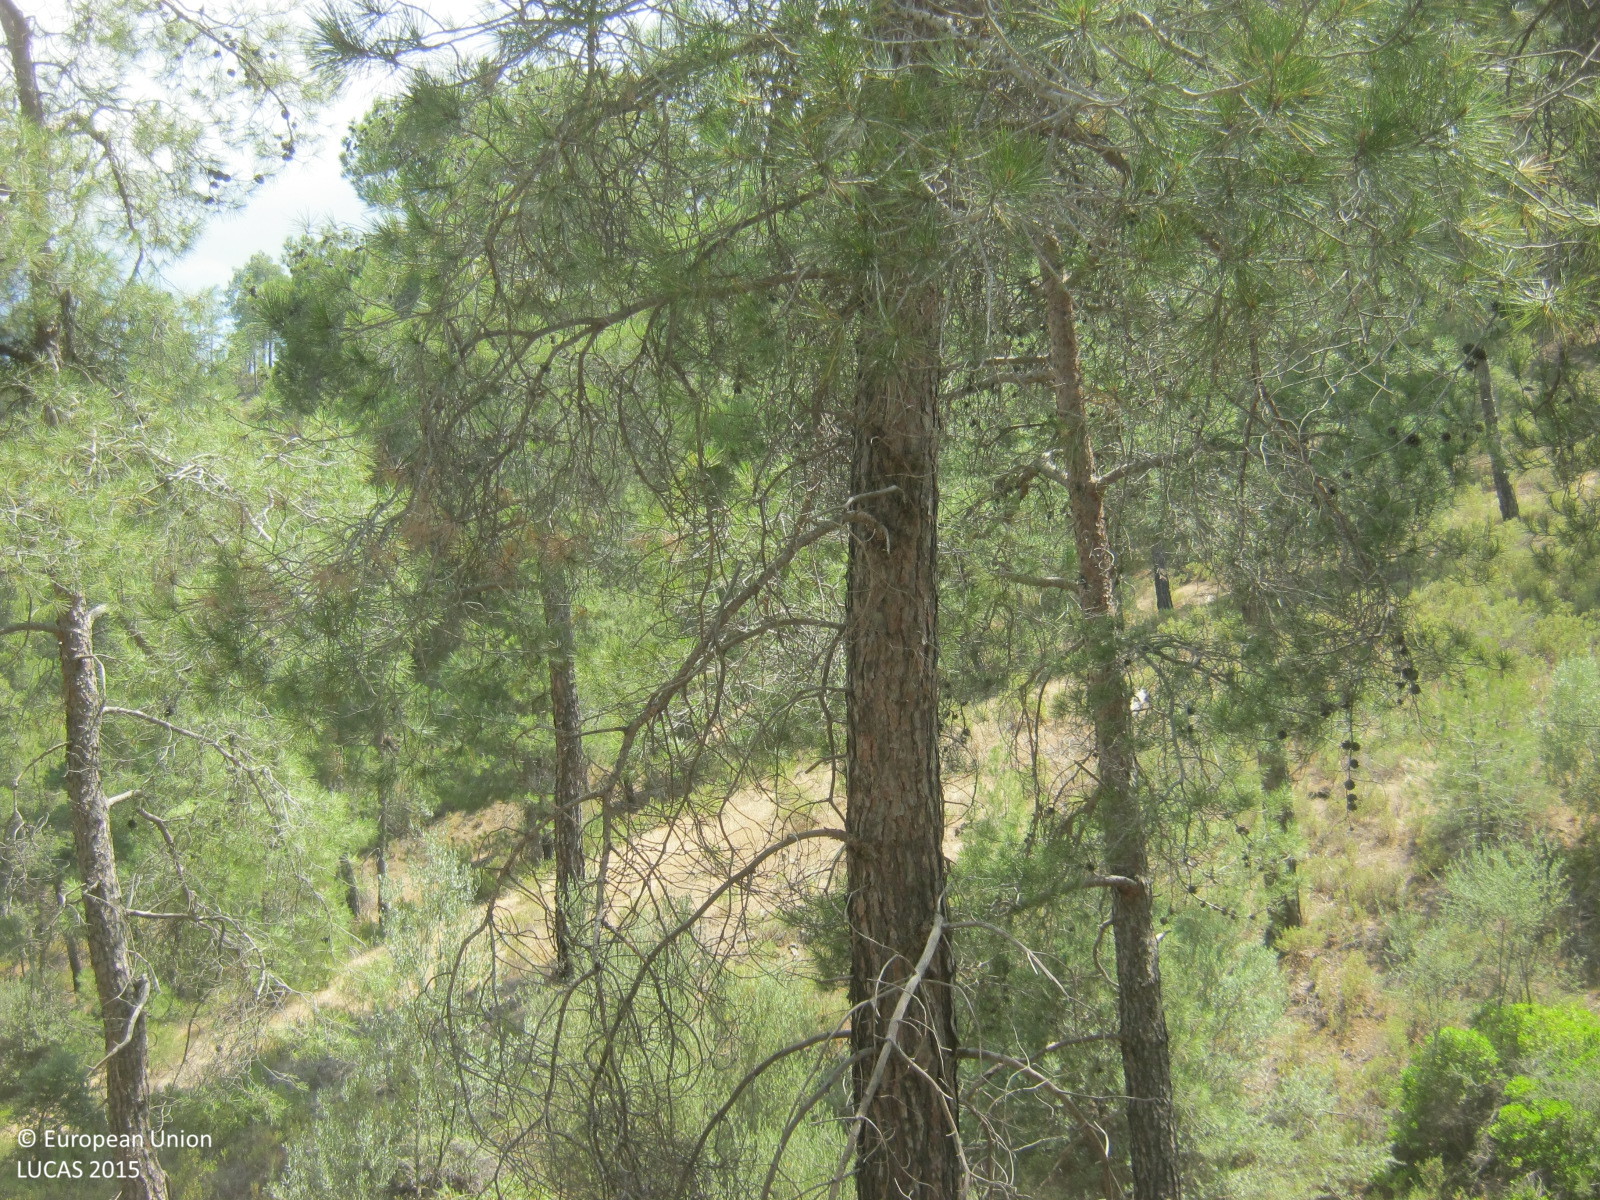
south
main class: Woodland
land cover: Pine dominated coniferous woodland
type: coniferous forest of the mediterranean region
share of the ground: 50 - 75 %
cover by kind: coniferous forest trees 60 %, herbaceous plants 20 %, shrubs 10 %, unconsolidated bare surface 10 %
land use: Forestry
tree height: > 5 m
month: June
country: CY
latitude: 34.9968
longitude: 33.0868
